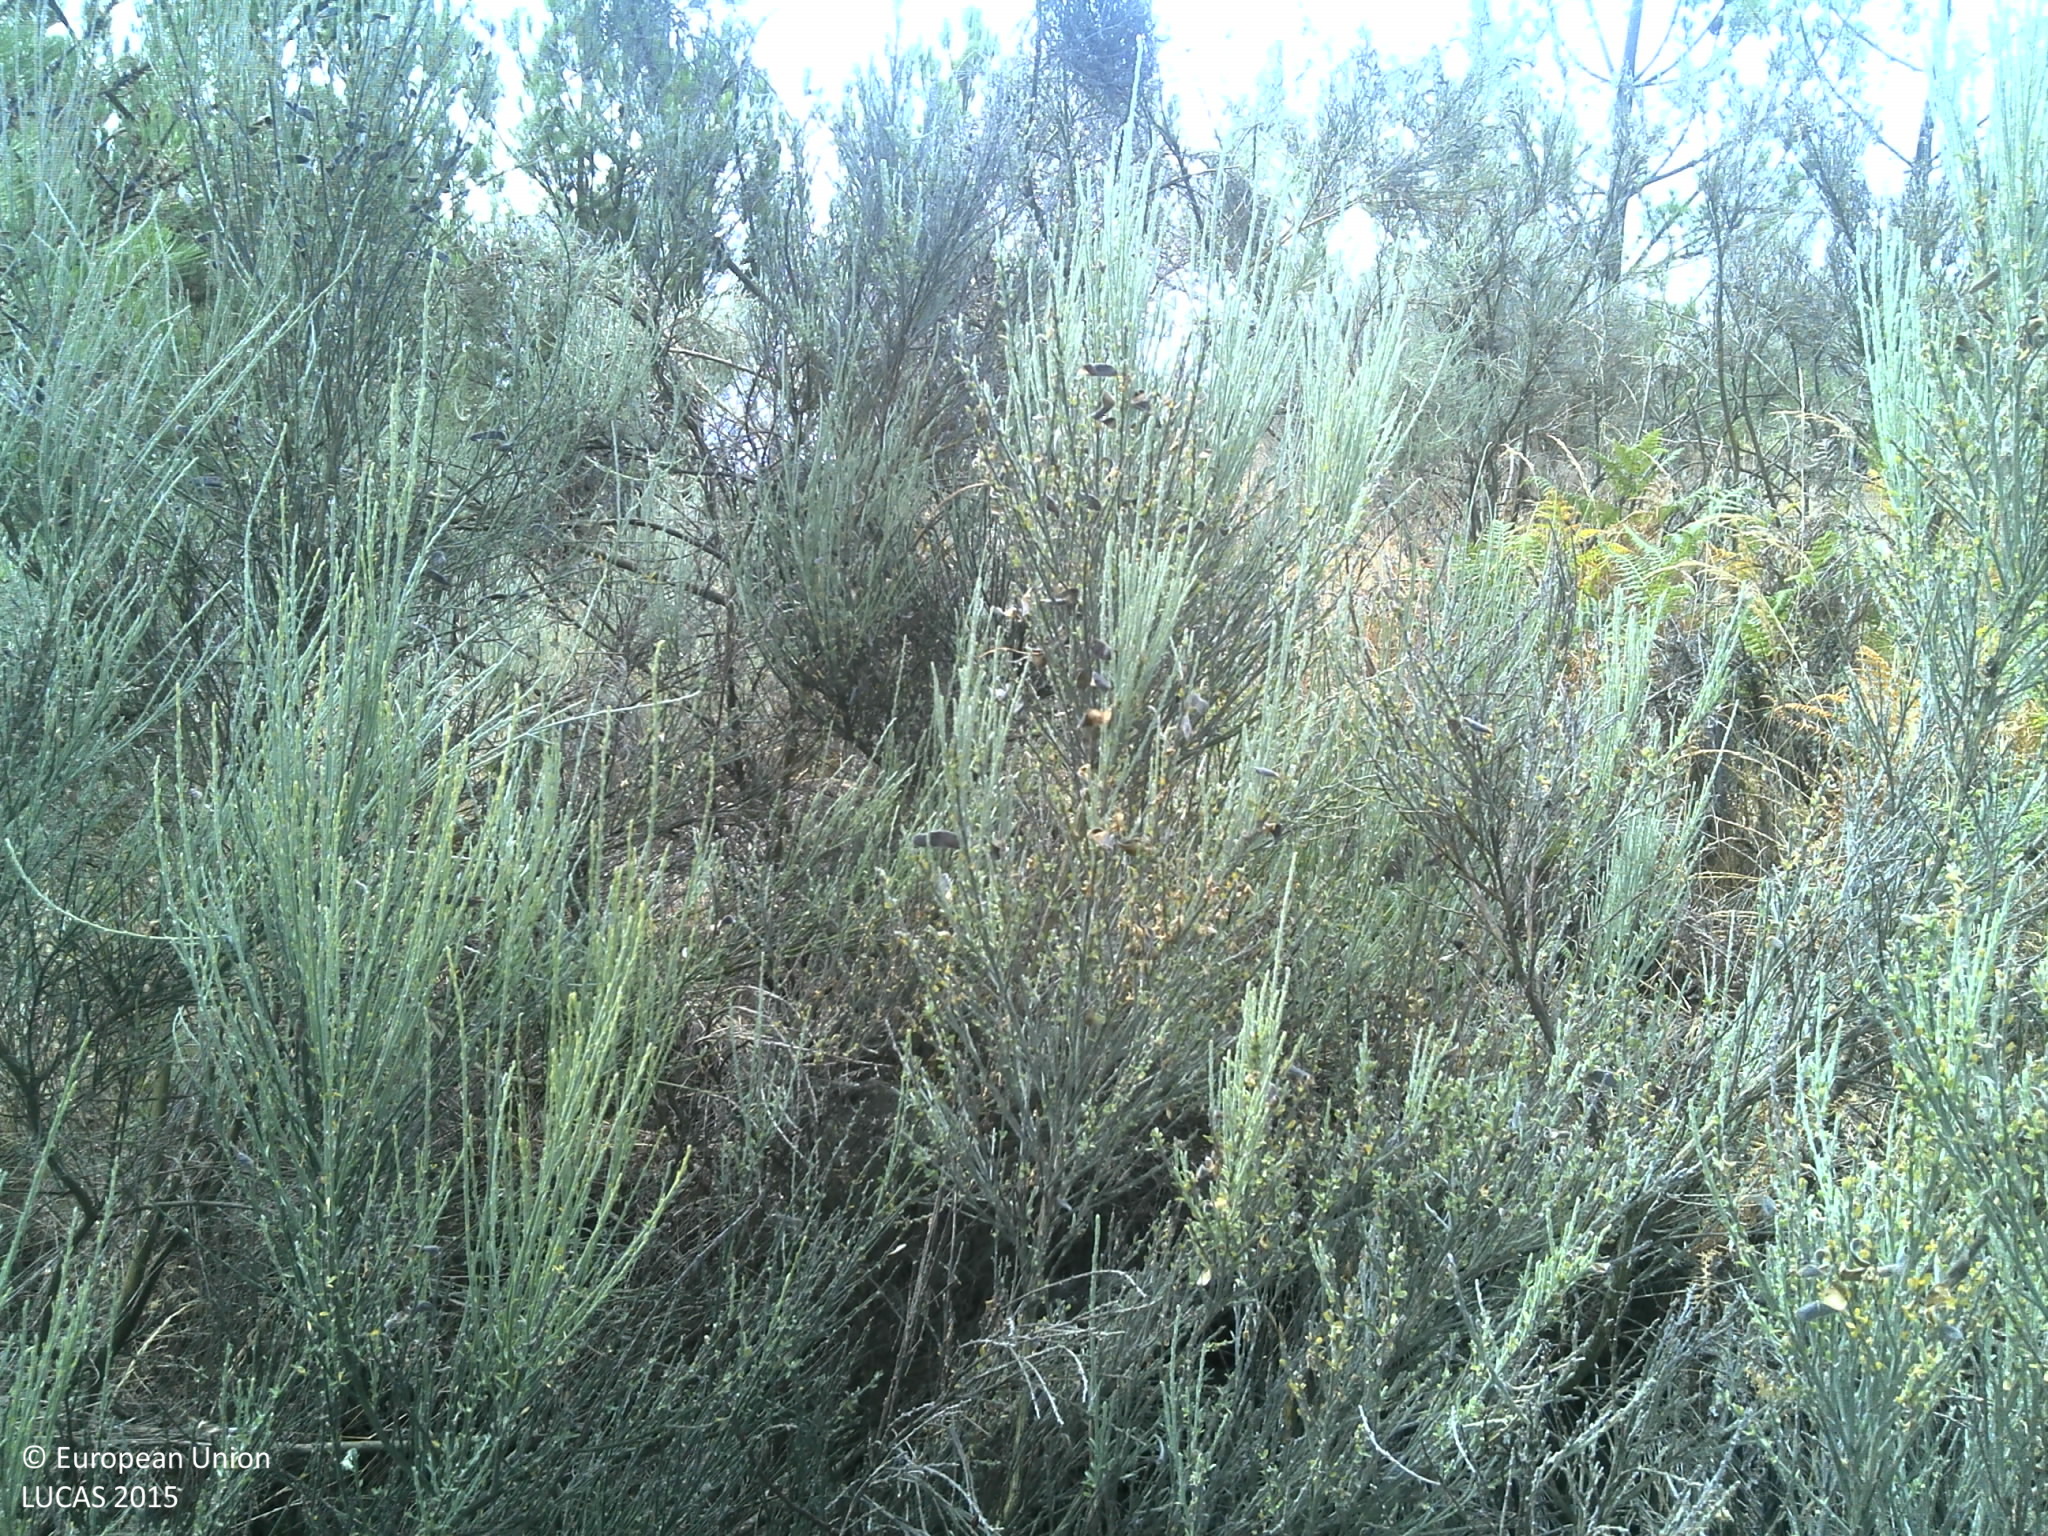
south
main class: Woodland
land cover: Pine dominated coniferous woodland
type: coniferous forest of the mediterranean region
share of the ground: 50 - 75 %
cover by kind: coniferous forest trees 50 %, shrubs 50 %
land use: Forestry
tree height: > 5 m
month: July
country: PT
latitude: 40.9405
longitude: -7.3492
